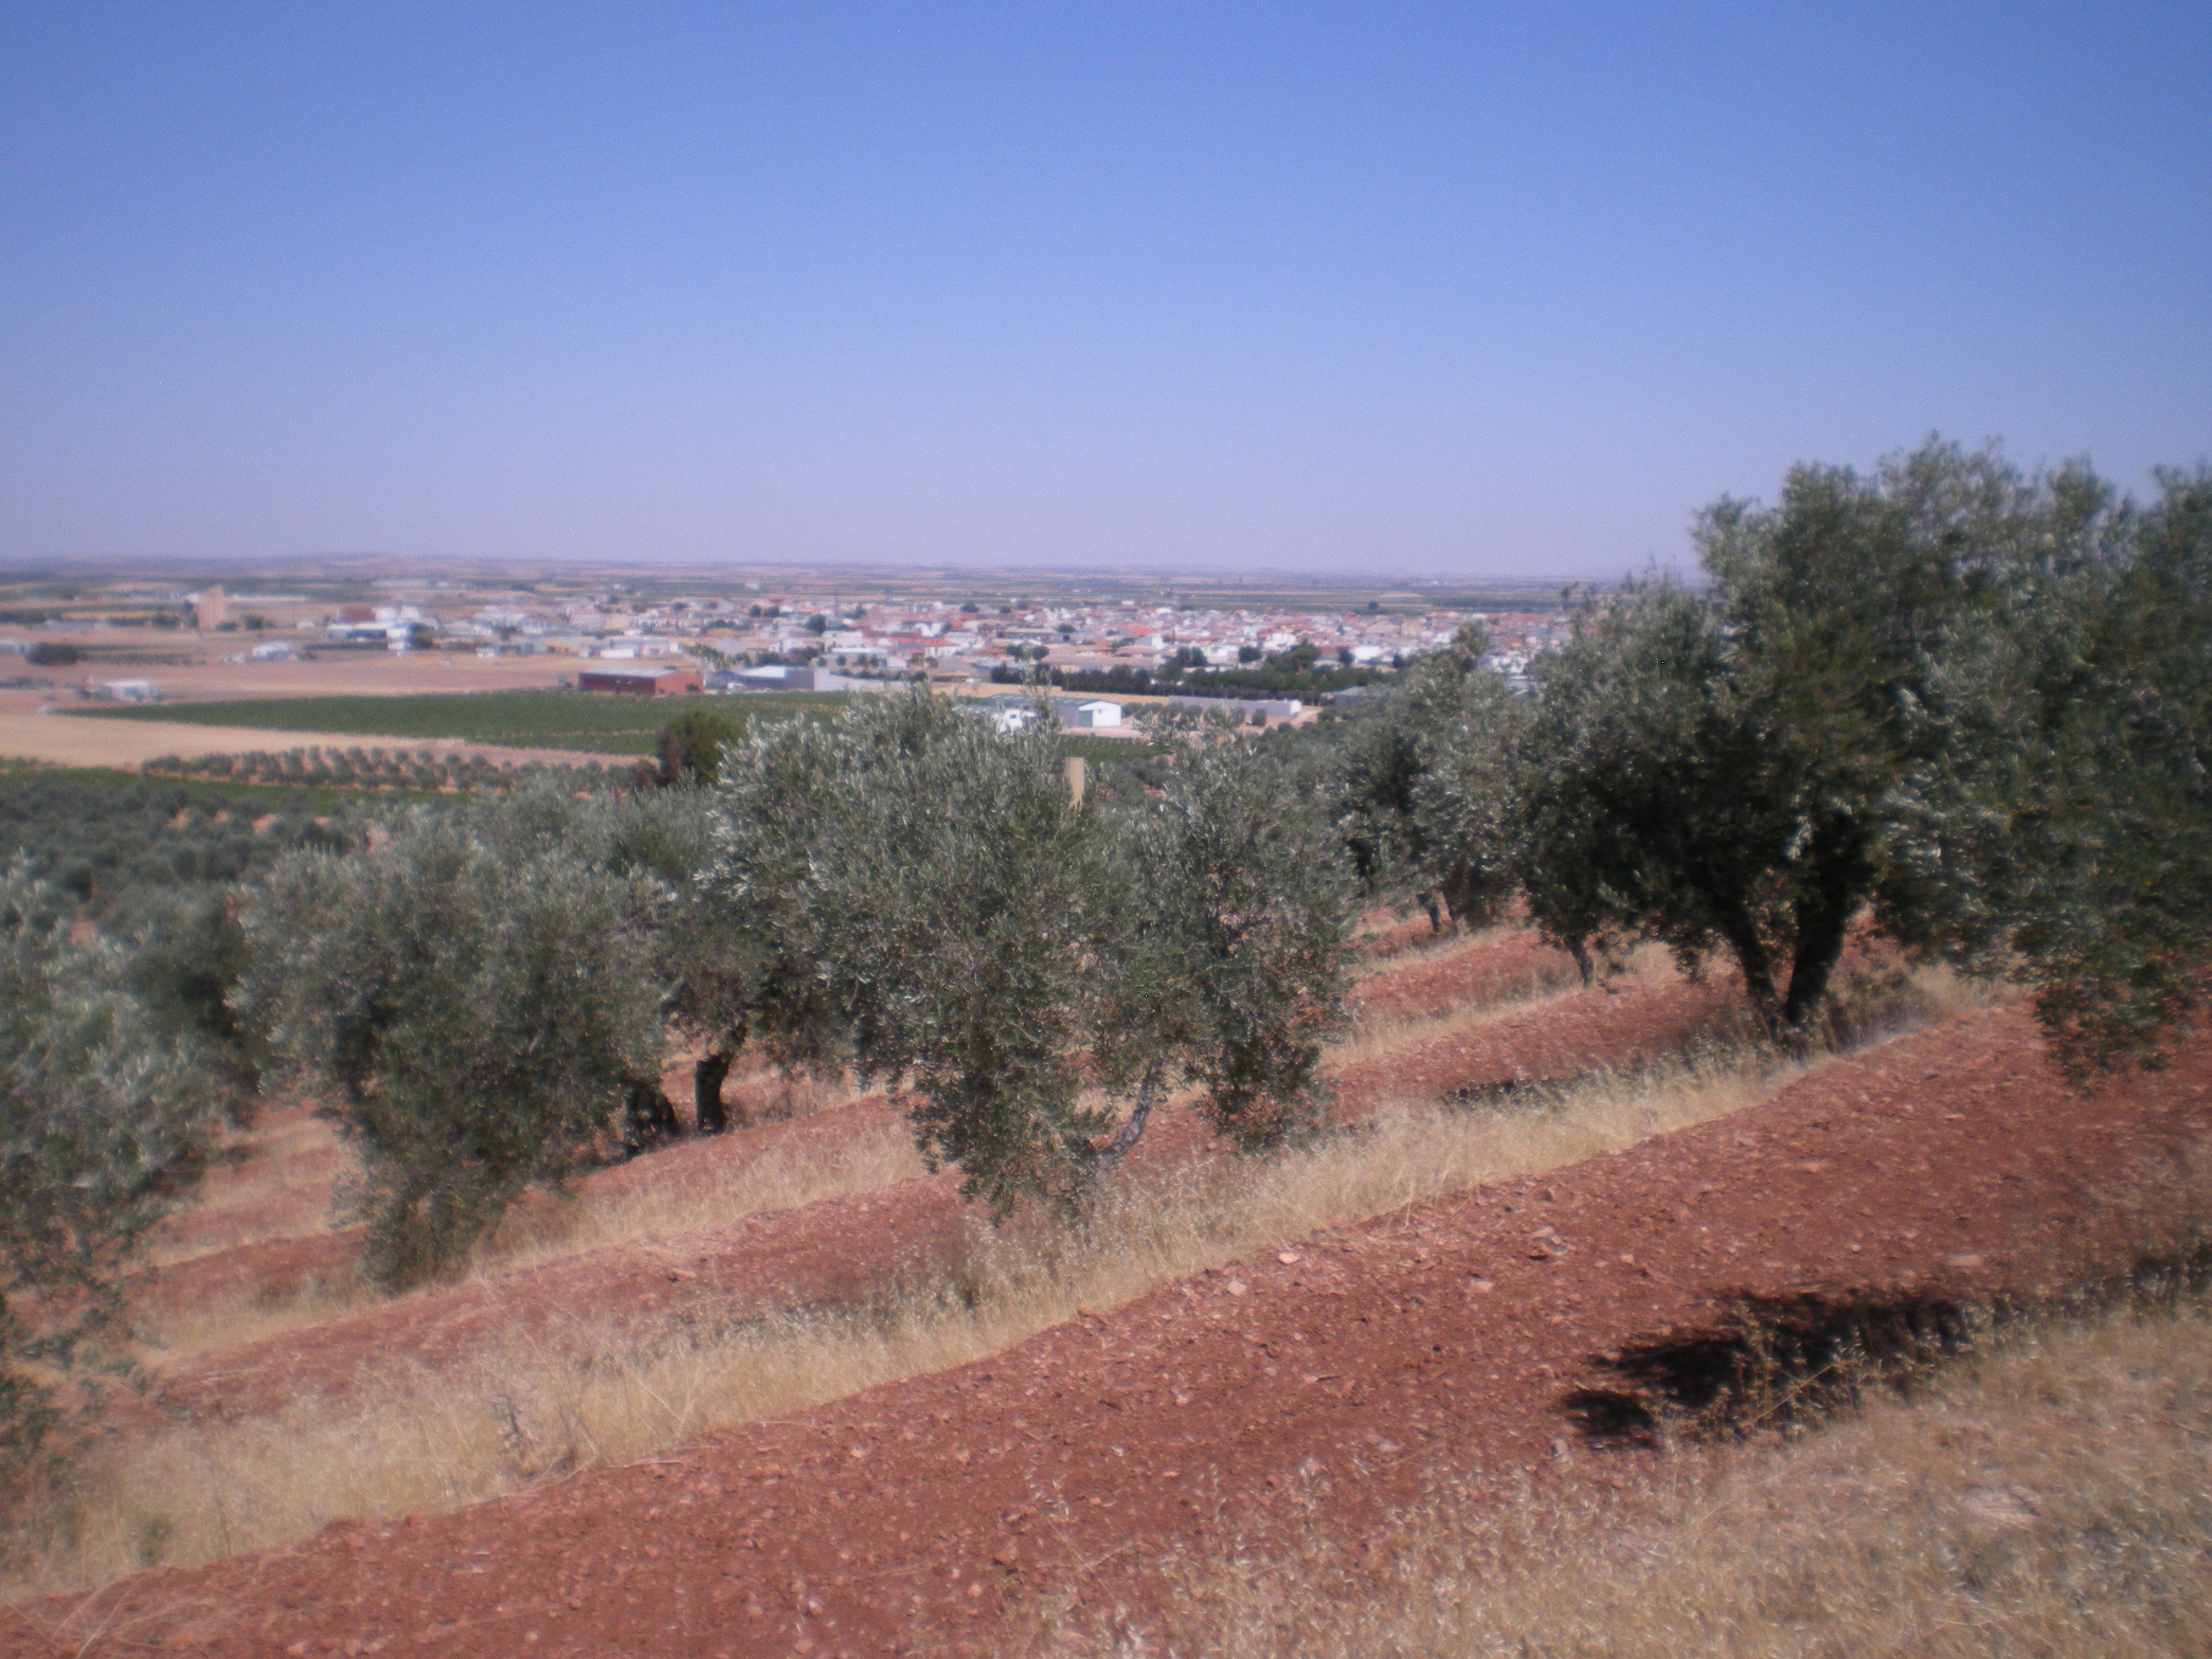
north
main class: Cropland
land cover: Olive groves
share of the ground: 25 - 50 %
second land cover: Spontaneously vegetated surfaces
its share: 10 - 25 %
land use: Agriculture (excluding fallow land and kitchen gardens)
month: July
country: ES
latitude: 39.3502
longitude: -3.3520
